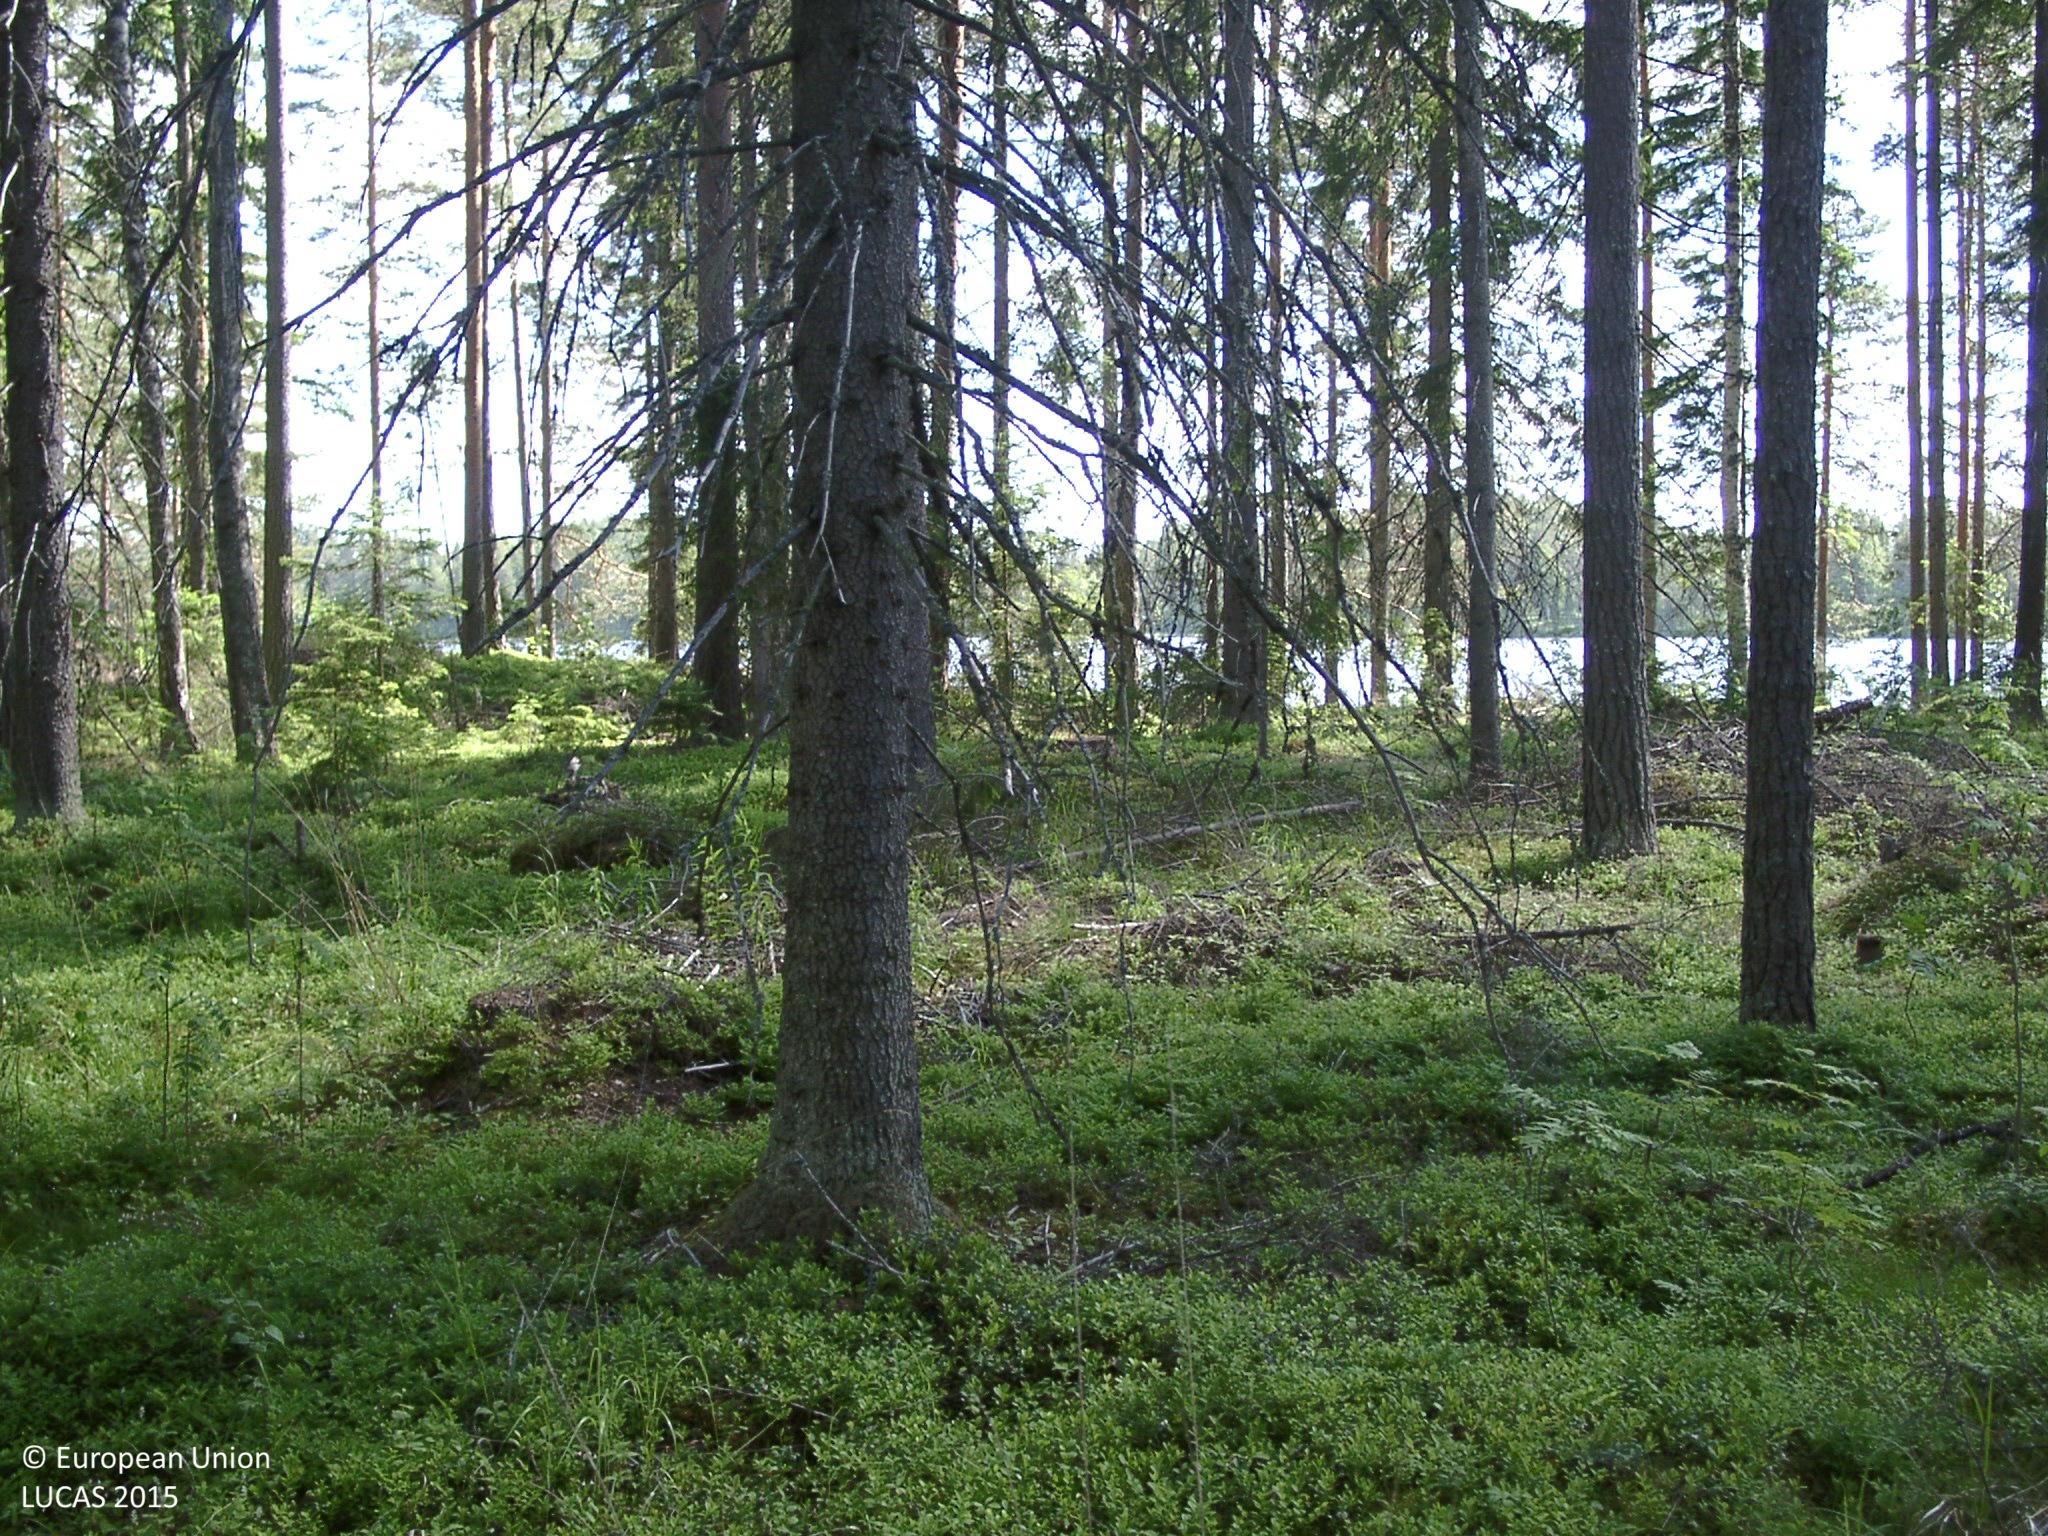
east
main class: Woodland
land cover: Other coniferous woodland
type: boreal forest
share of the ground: 50 - 75 %
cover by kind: coniferous forest trees 60 %, shrubs 30 %, broadleaved forest trees 5 %, herbaceous plants 5 %
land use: Forestry
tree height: > 5 m
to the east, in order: Other coniferous woodland; Tracks; Other coniferous woodland; Tracks; Other coniferous woodland; Tracks; Pine dominated coniferous woodland; Inland fresh water bodies
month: June
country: FI
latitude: 62.0878
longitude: 25.0608
